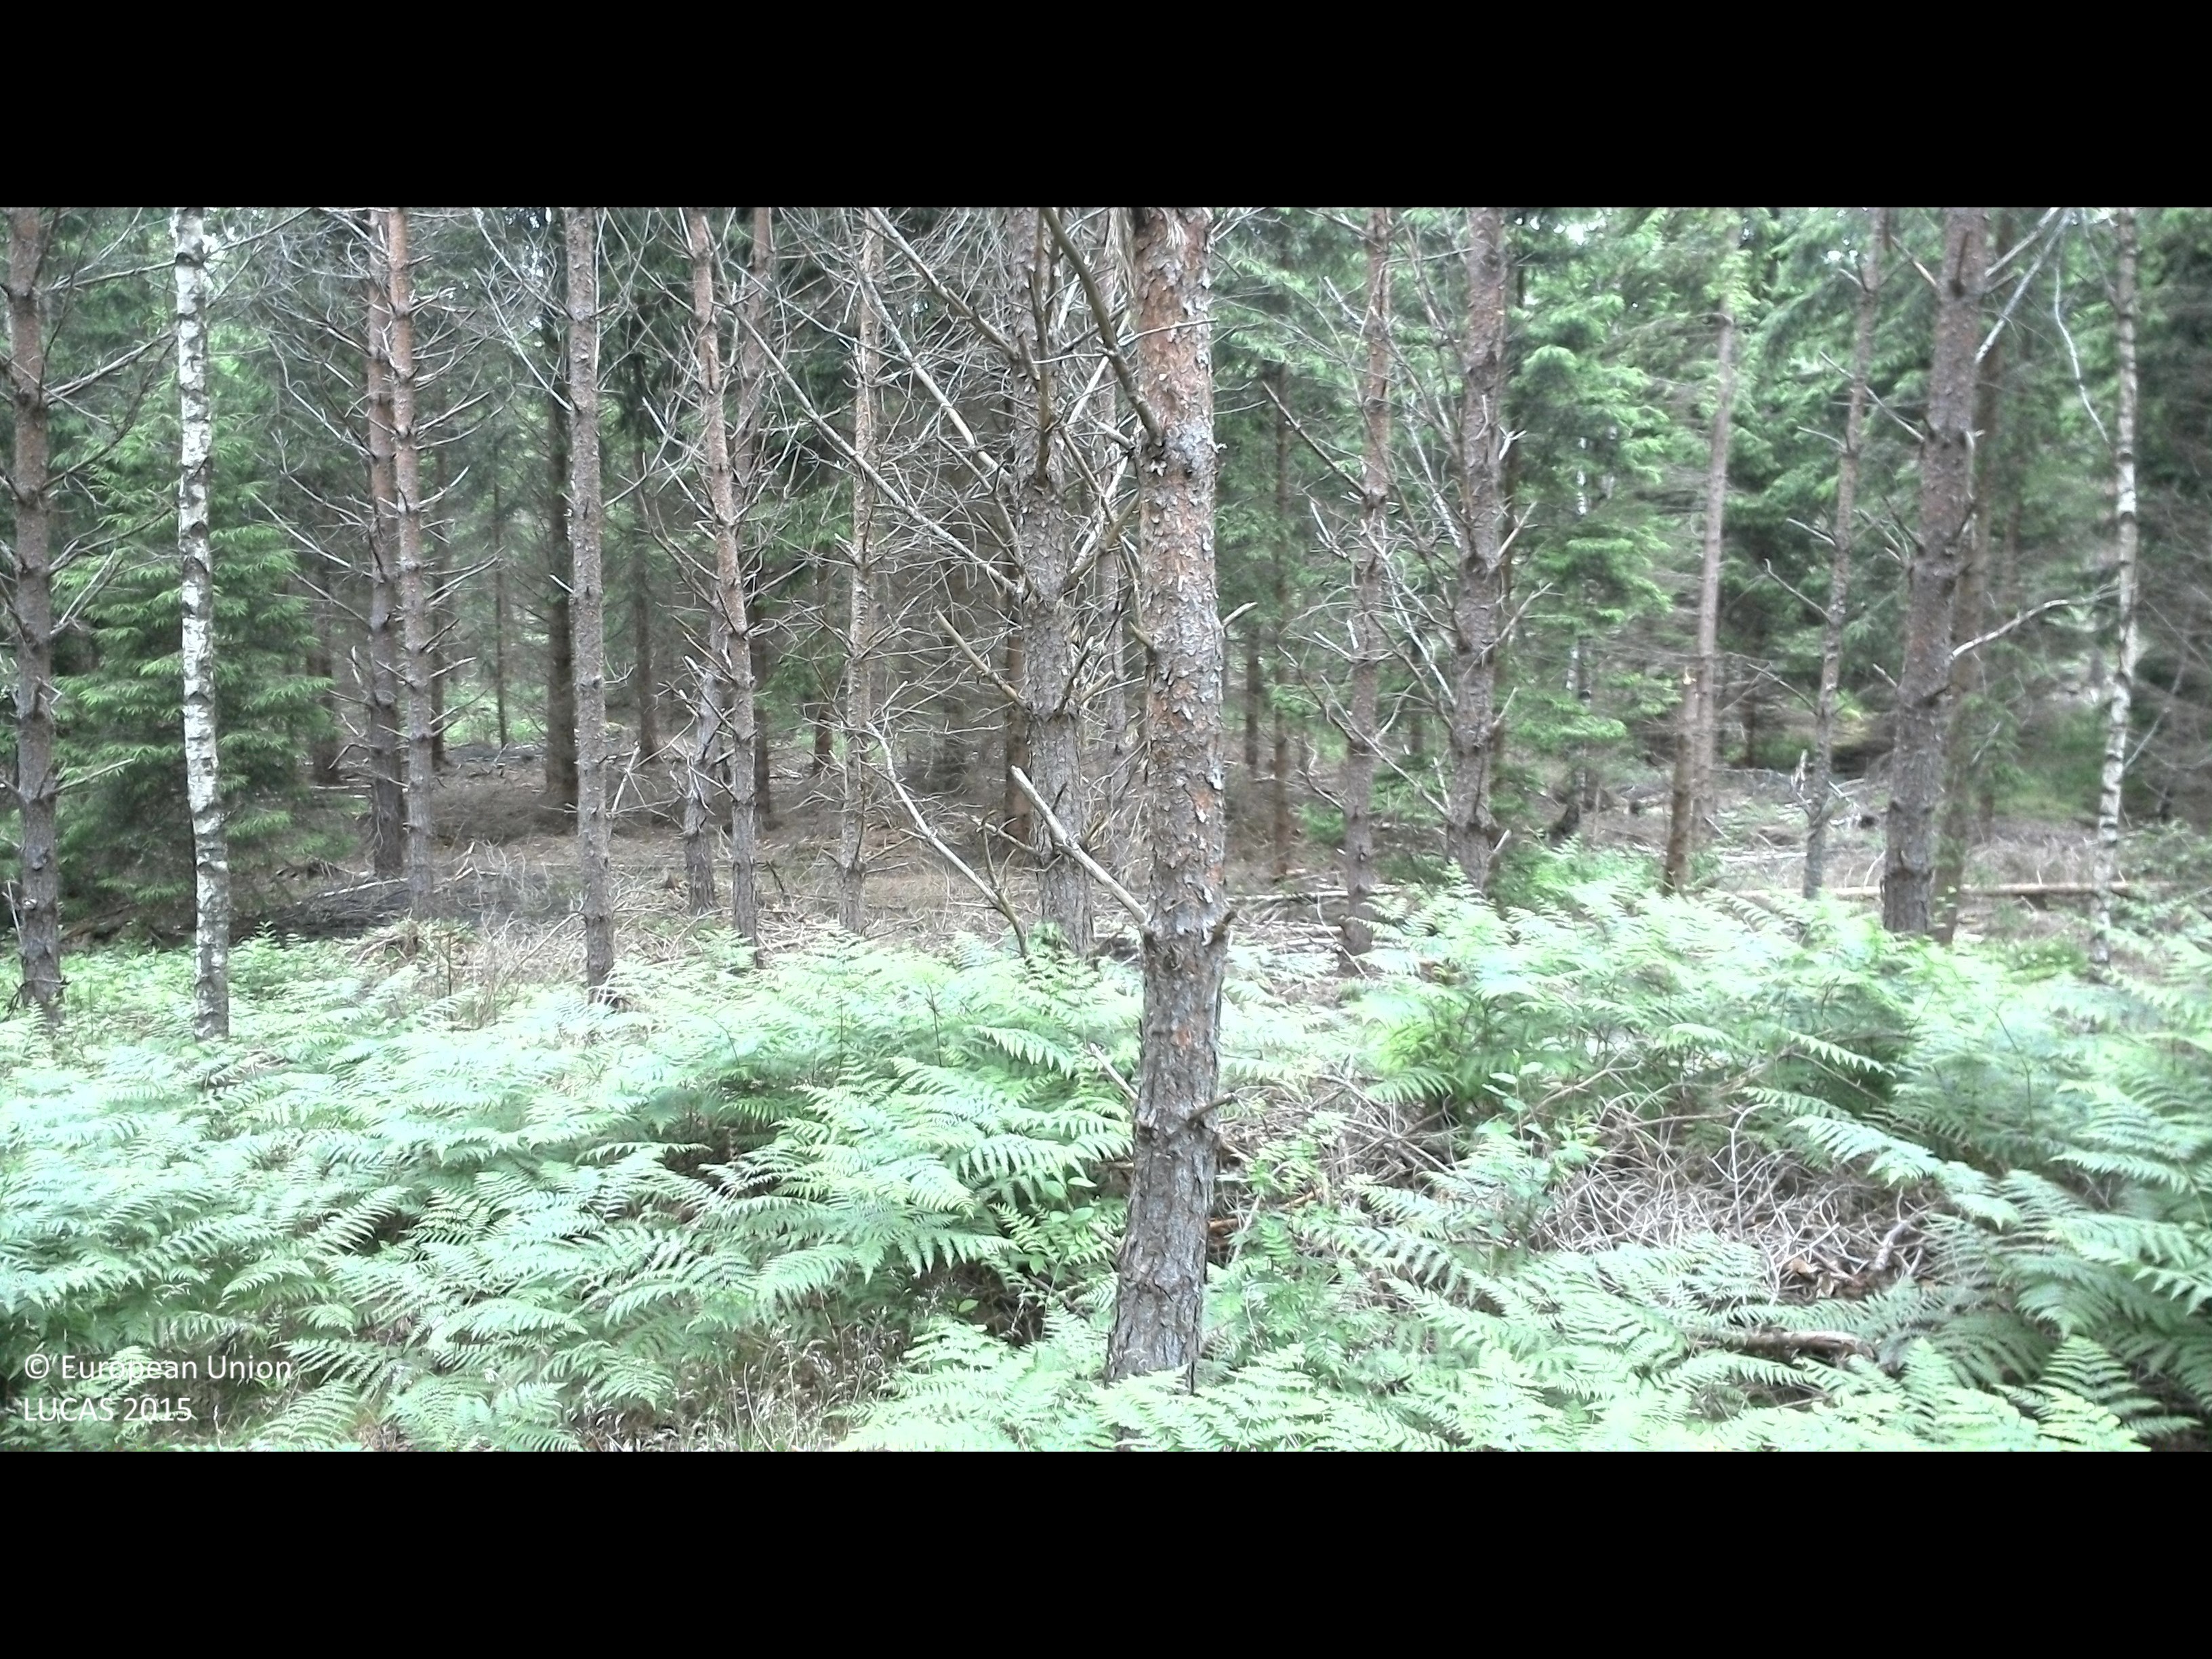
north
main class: Woodland
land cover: Pine dominated coniferous woodland
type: boreal forest
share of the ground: 50 - 75 %
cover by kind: coniferous forest trees 50 %, herbaceous plants 40 %, broadleaved forest trees 5 %, lichens and mosses 5 %
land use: Forestry
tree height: > 5 m
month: June
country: SE
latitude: 56.4940
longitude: 16.0915
